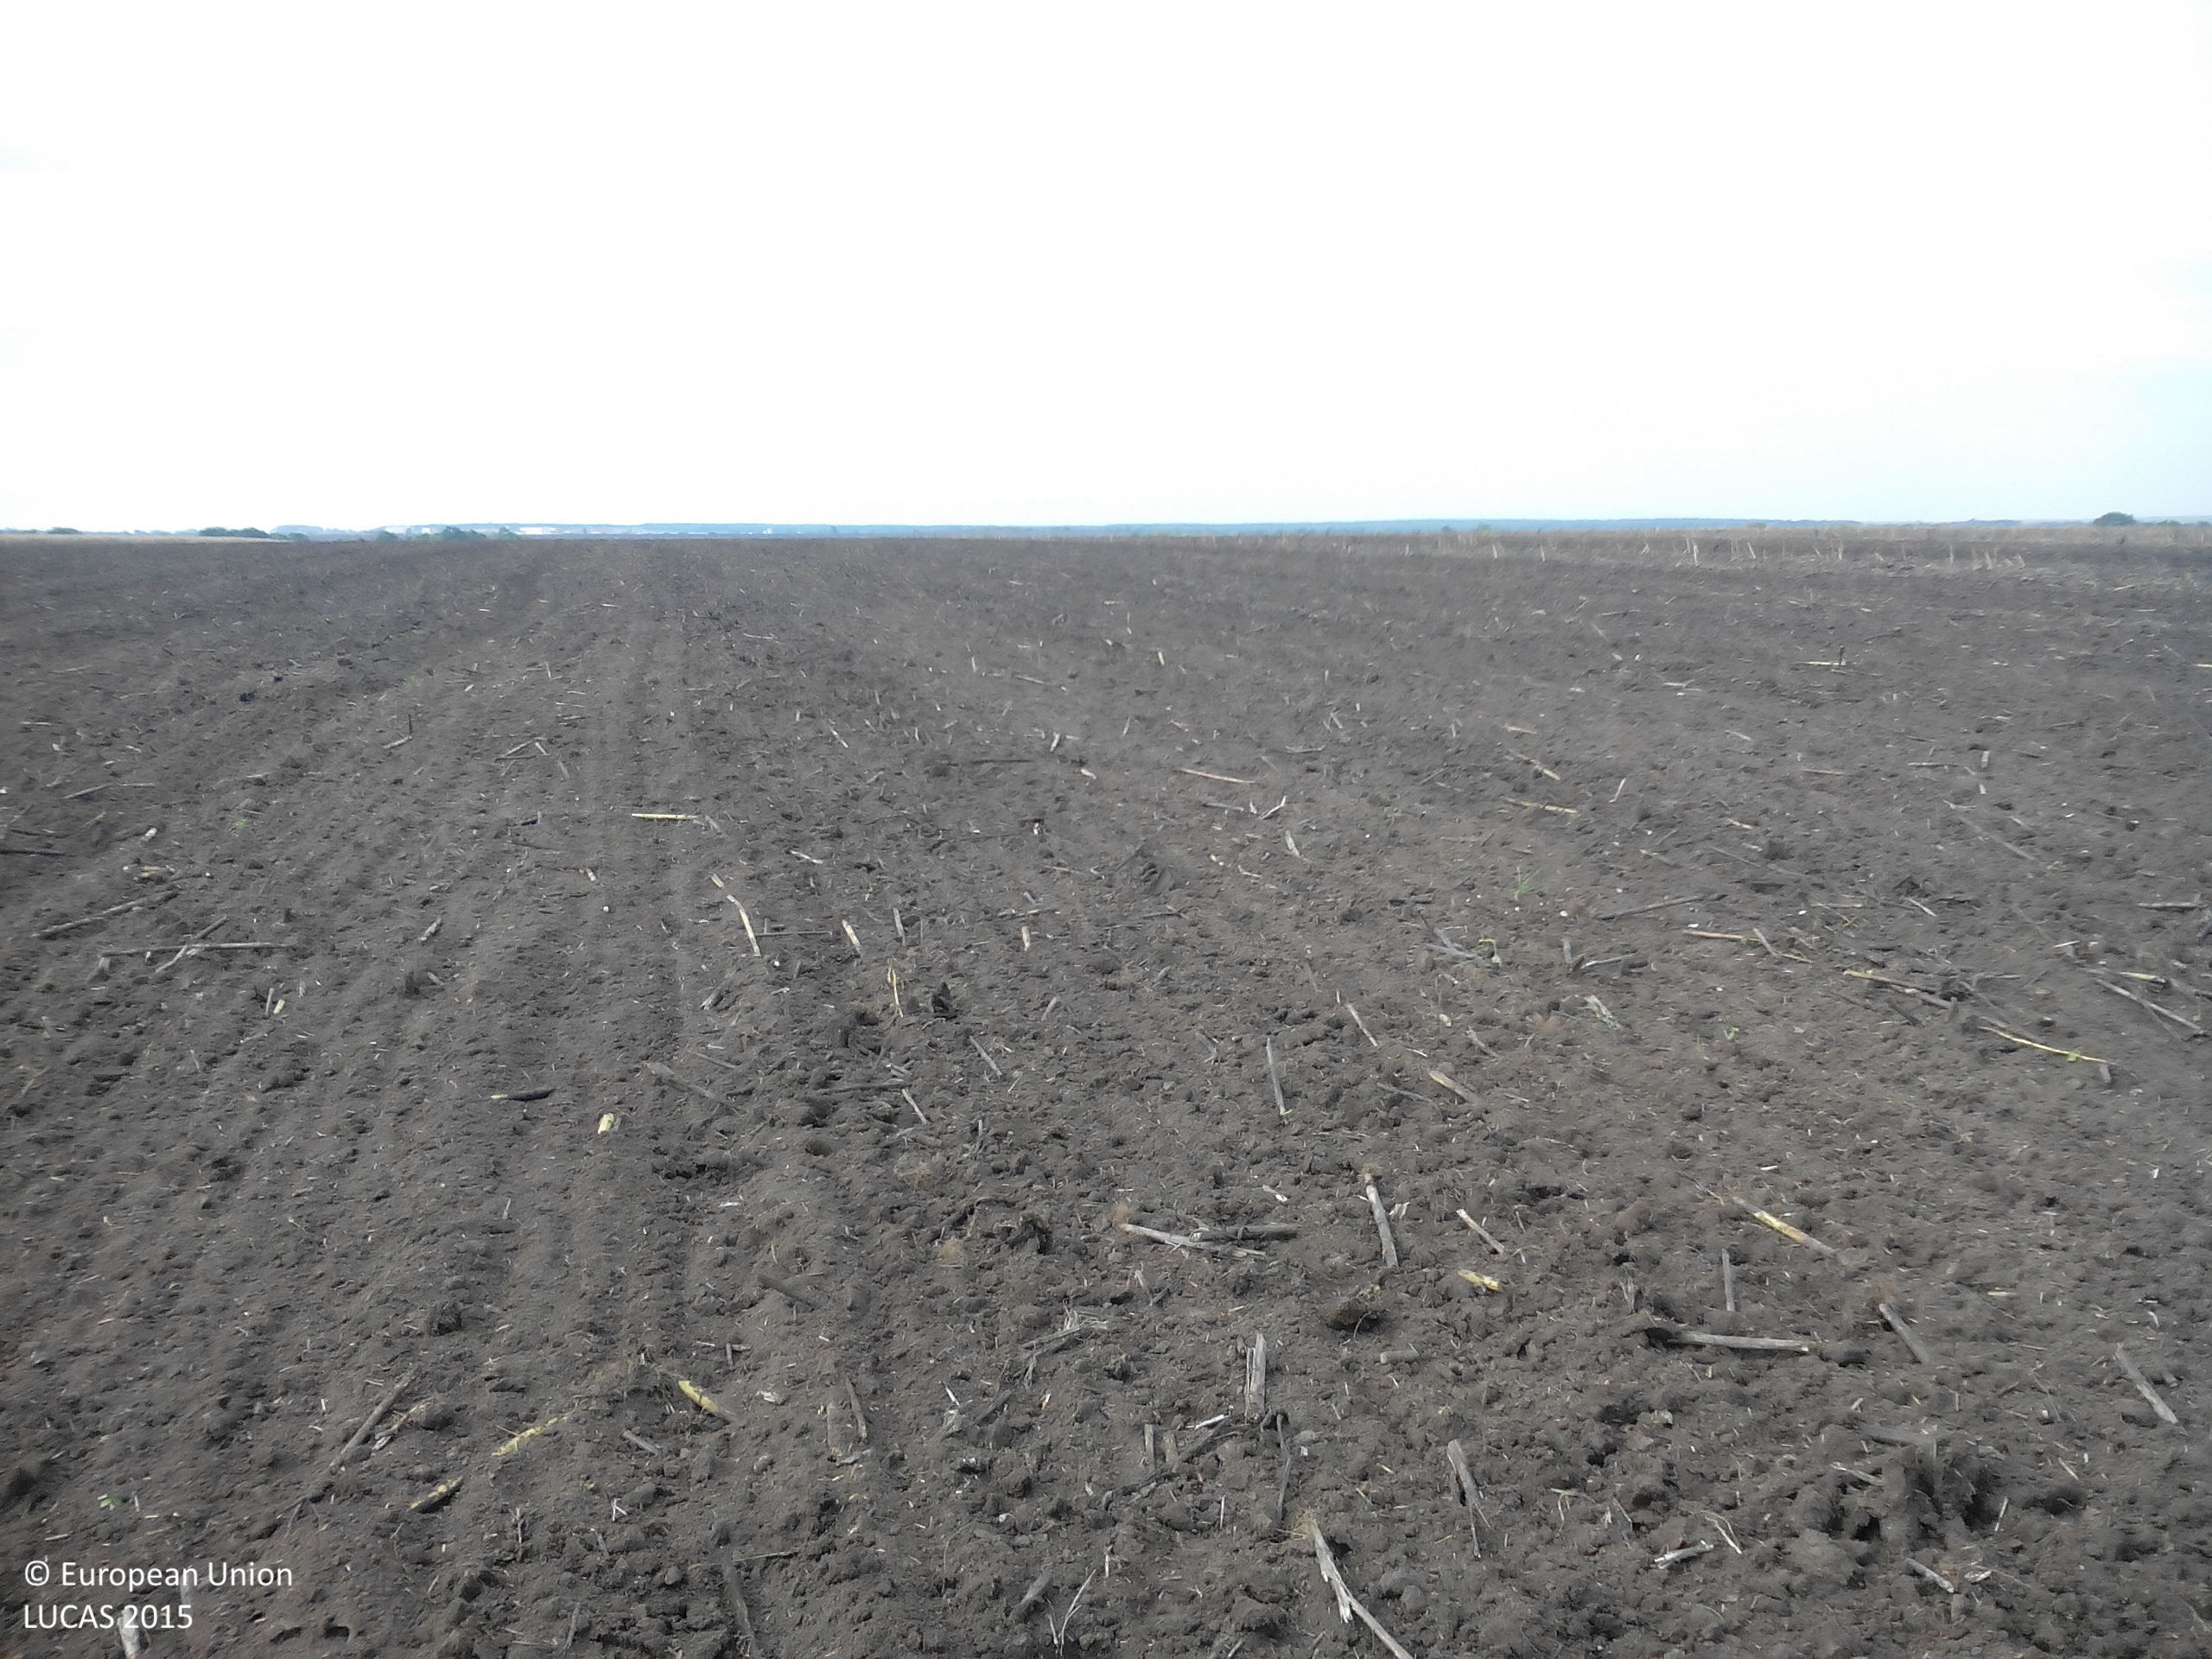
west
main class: Cropland
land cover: Sunflower
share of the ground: < 10 %
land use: Agriculture (excluding fallow land and kitchen gardens)
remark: Harvested field
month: October
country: BG
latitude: 43.3551
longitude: 23.6295
